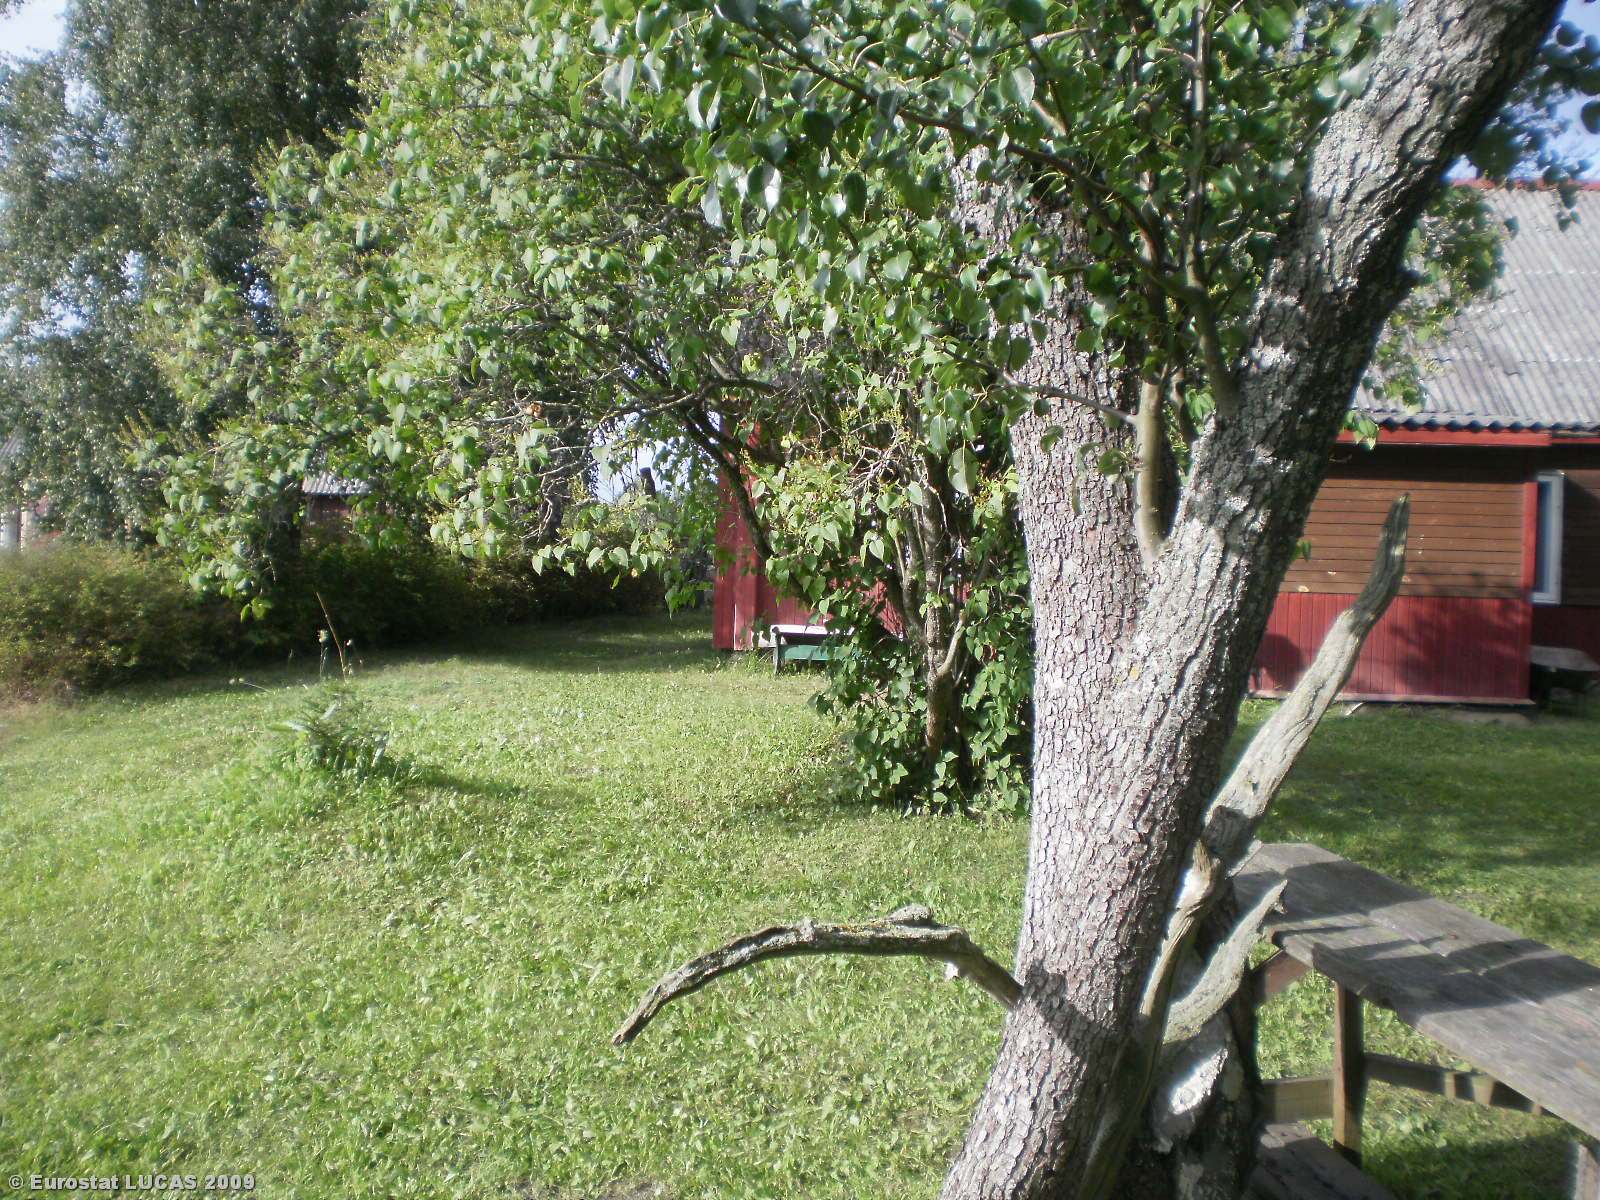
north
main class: Grassland
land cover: Grassland with sparse tree/shrub cover
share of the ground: > 75 %
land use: Residential
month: August
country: LT
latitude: 55.2446
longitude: 25.5892
